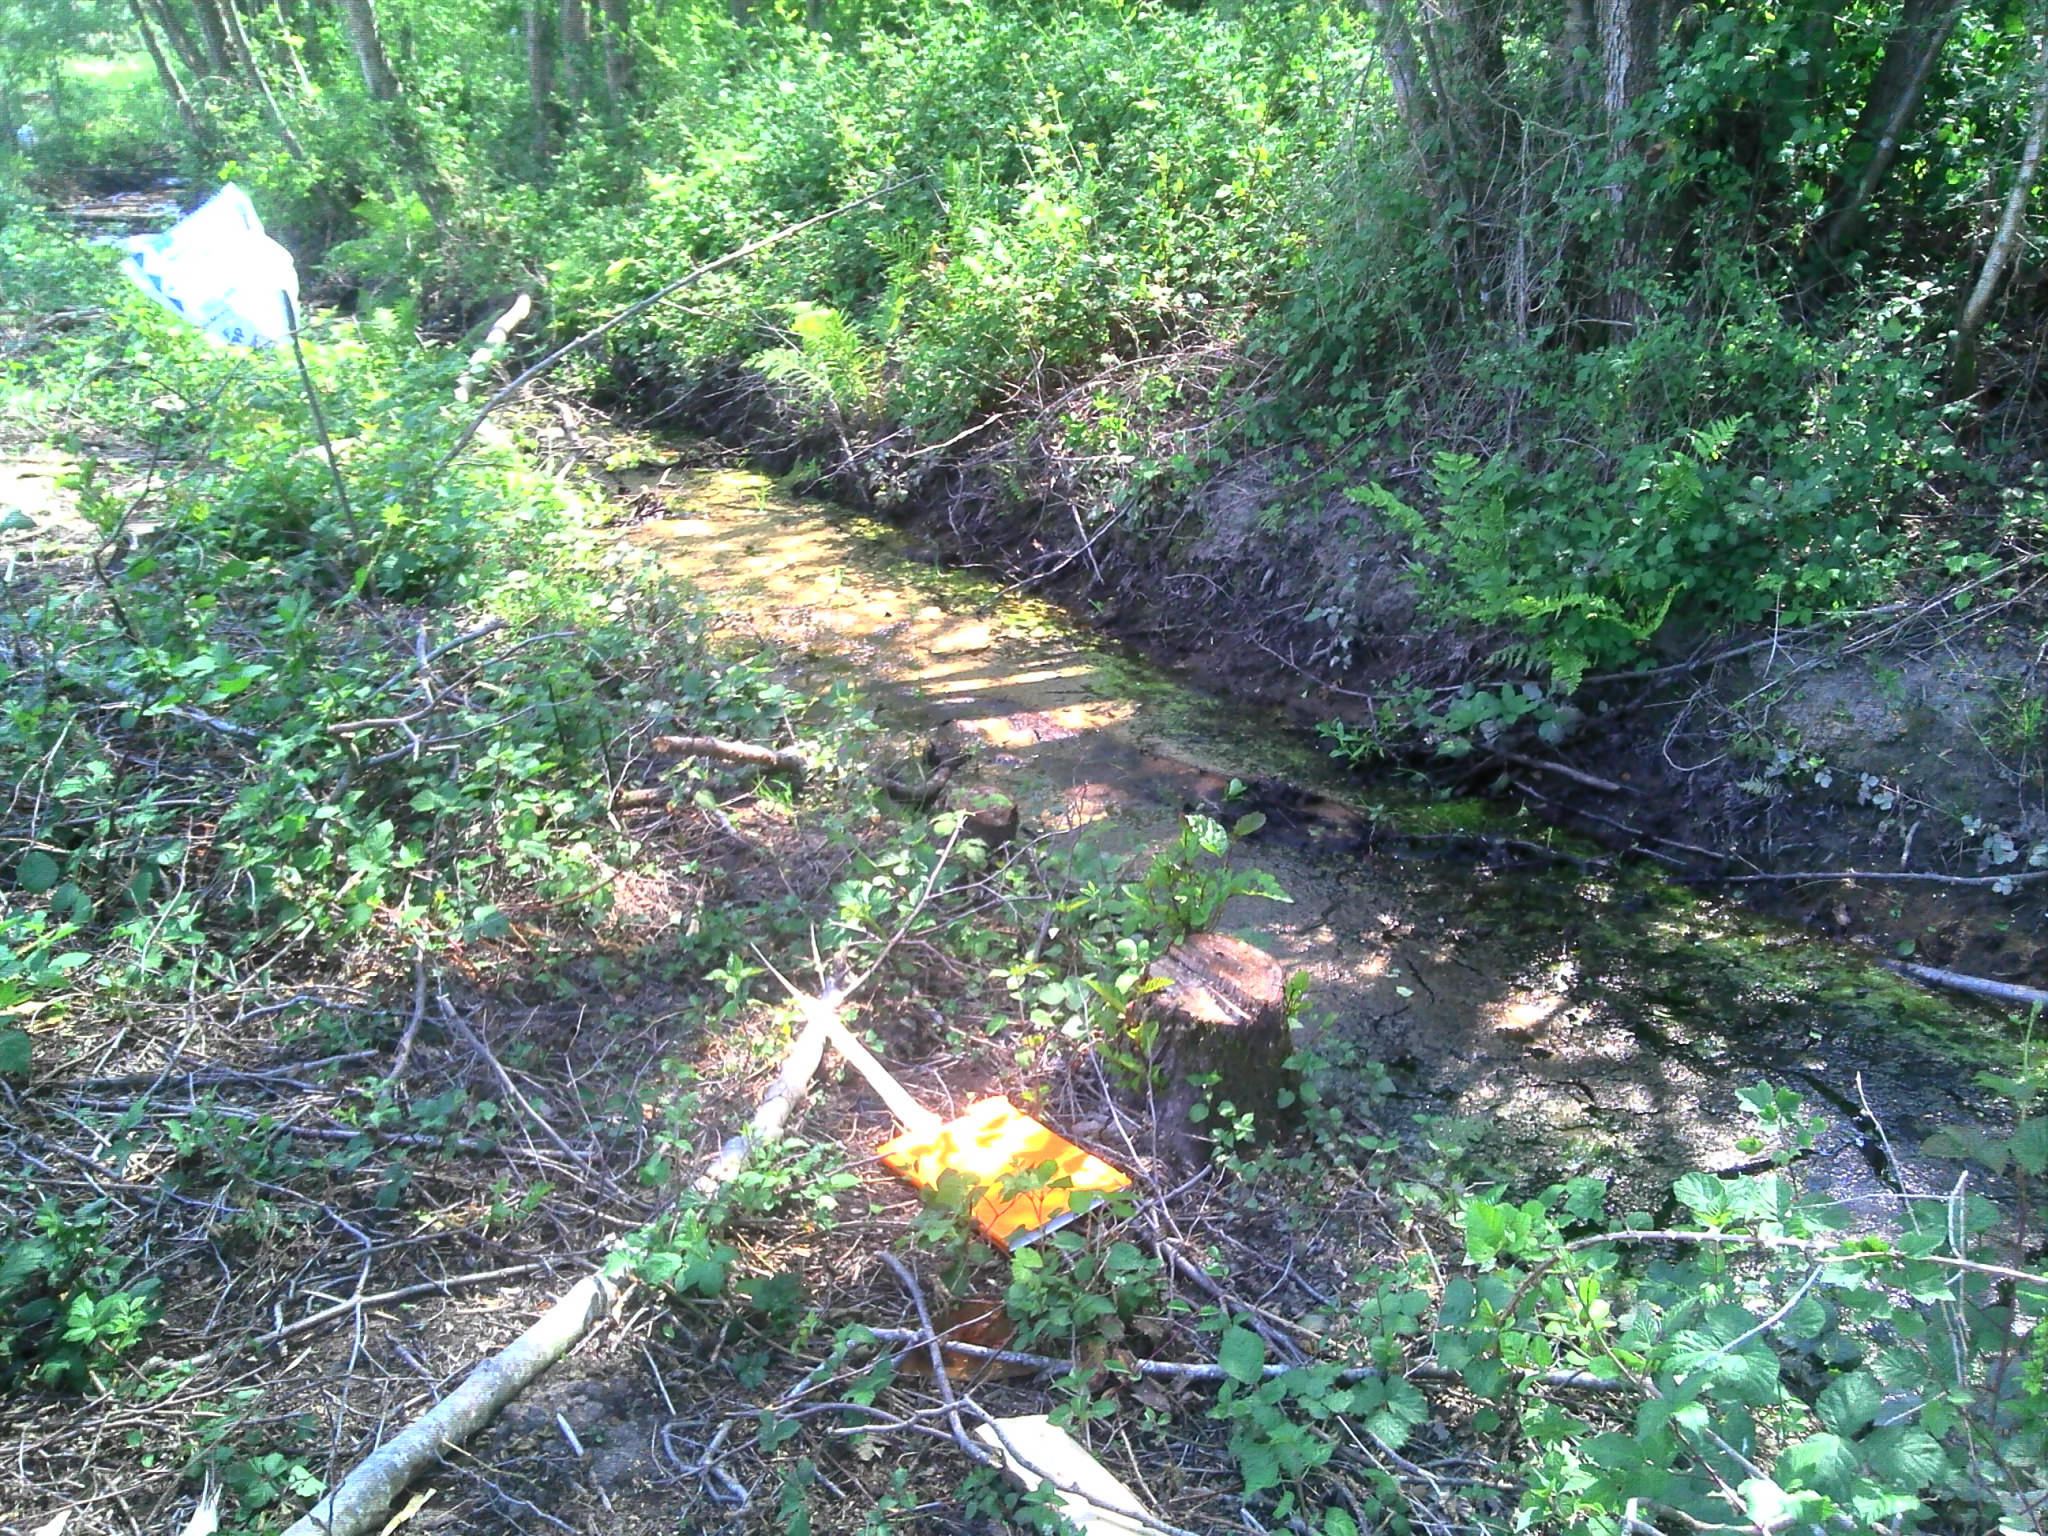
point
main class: Shrubland
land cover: Shrubland with sparse tree cover
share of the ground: 50 - 75 %
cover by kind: shrubs 60 %, herbaceous plants 20 %, consolidated bare surface 10 %, broadleaved forest trees 5 %, lichens and mosses 5 %
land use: Forestry
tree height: > 5 m
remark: Clear cut
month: May
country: FR
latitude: 46.5222
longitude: 4.9833
